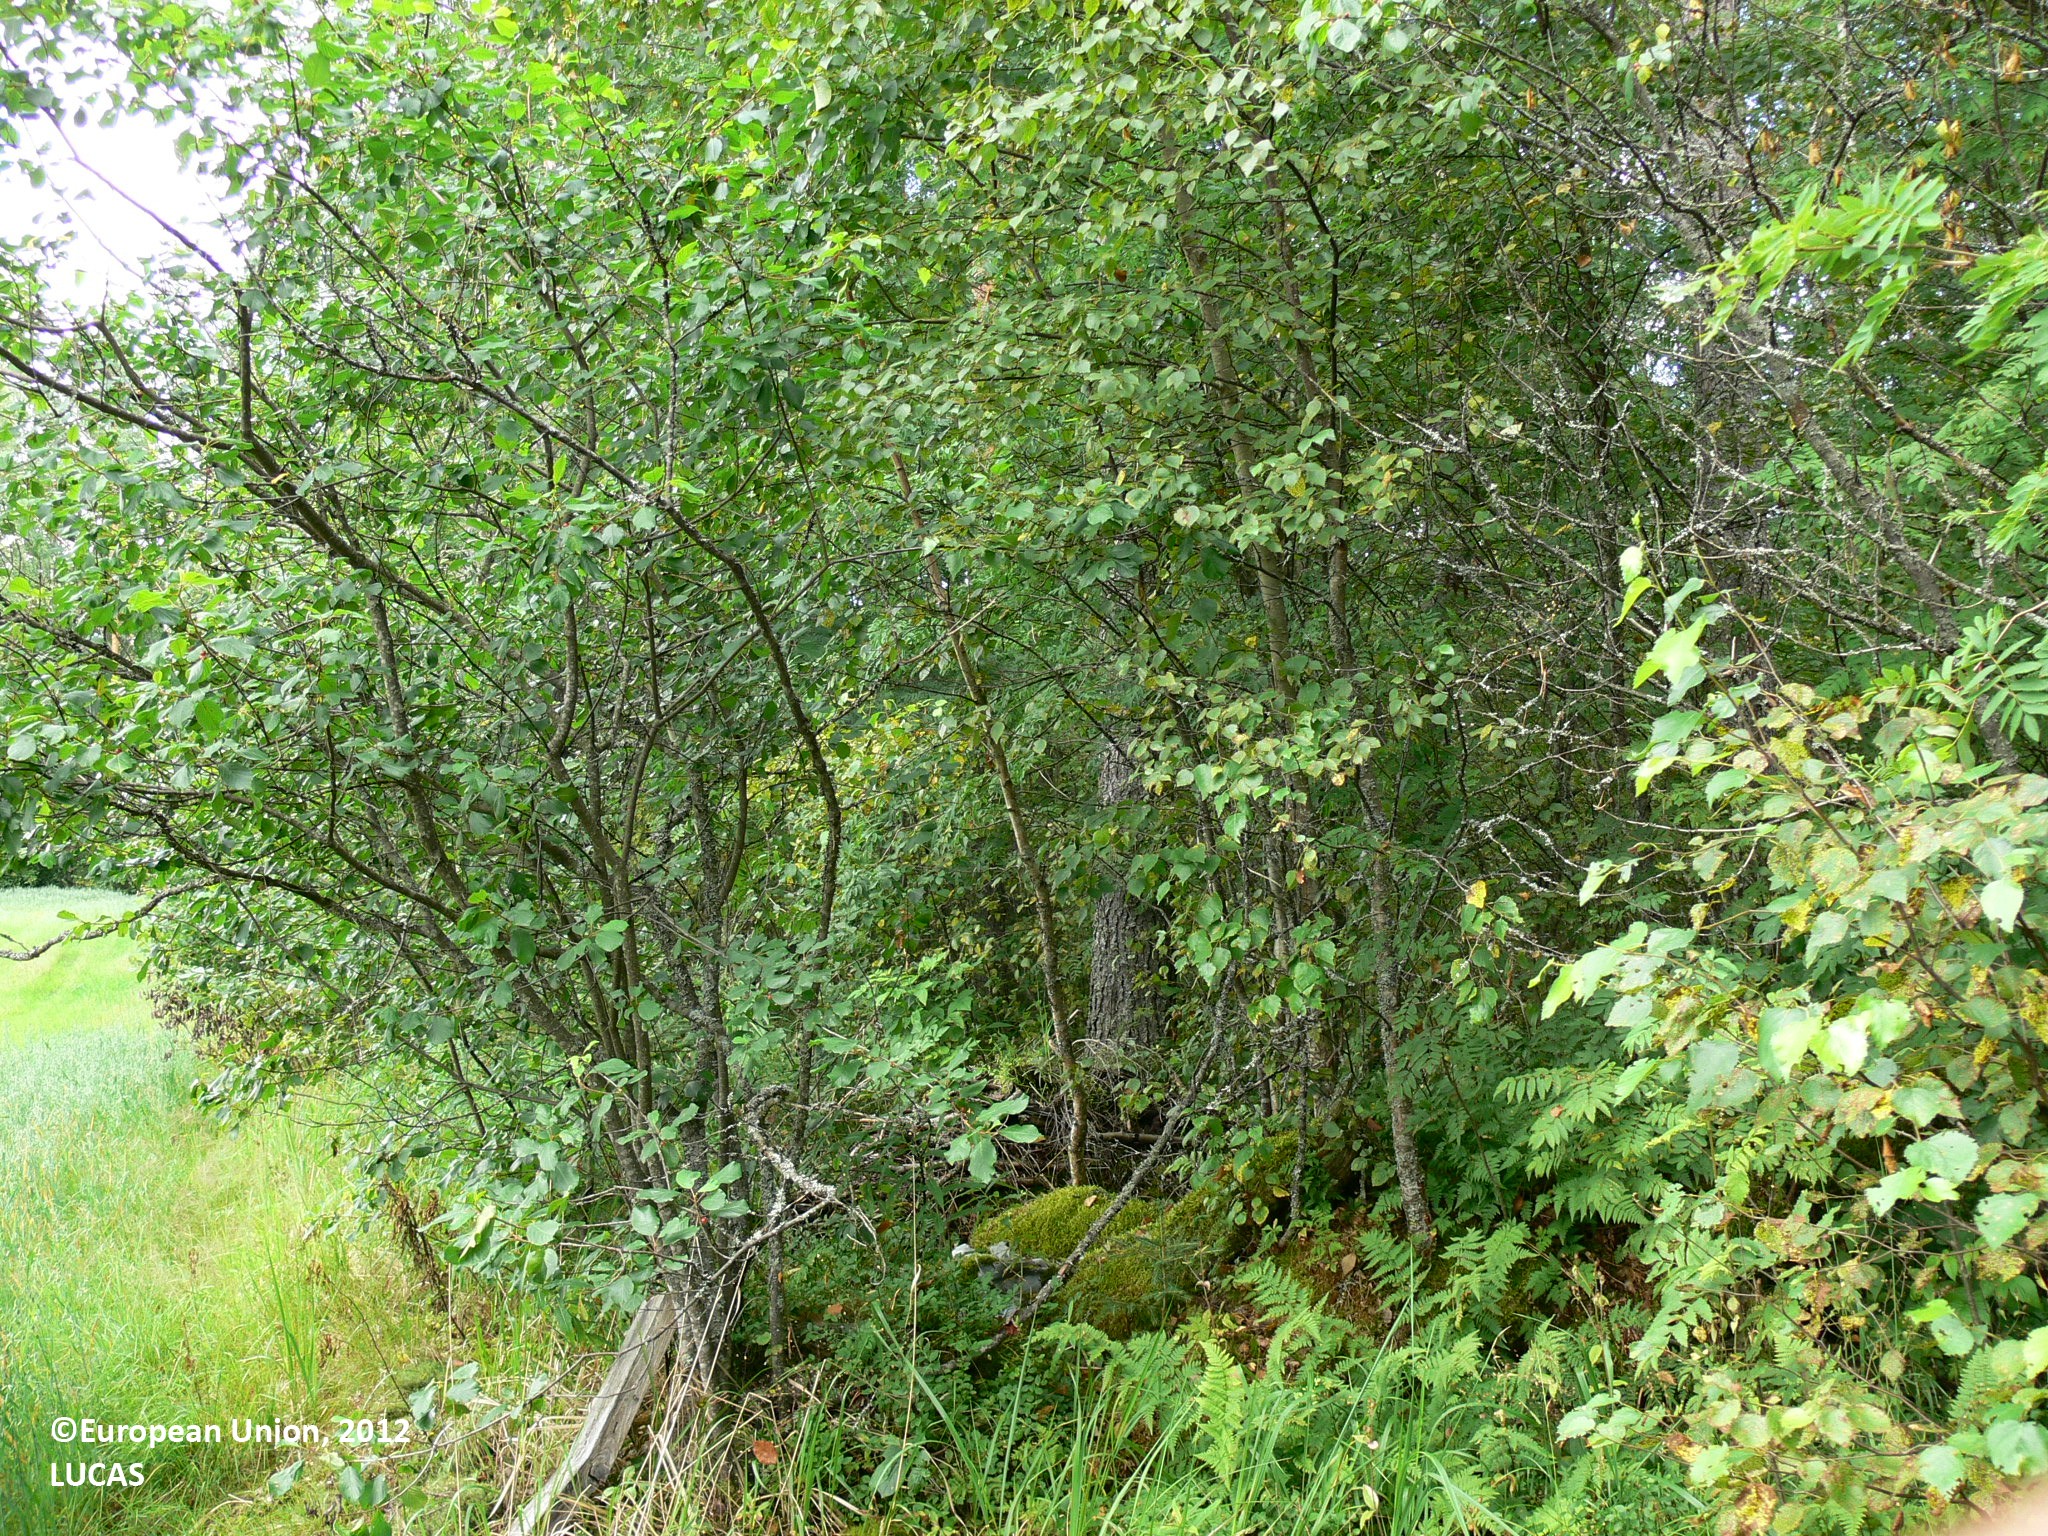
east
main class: Cropland
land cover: Oats
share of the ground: > 75 %
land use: Agriculture (excluding fallow land and kitchen gardens)
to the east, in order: Oats; Ditches and canals; Oats; Ditches and canals; Temporary grasslands; Ditches and canals; Spruce dominated mixed woodland
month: August
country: FI
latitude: 61.8526
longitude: 29.2582
